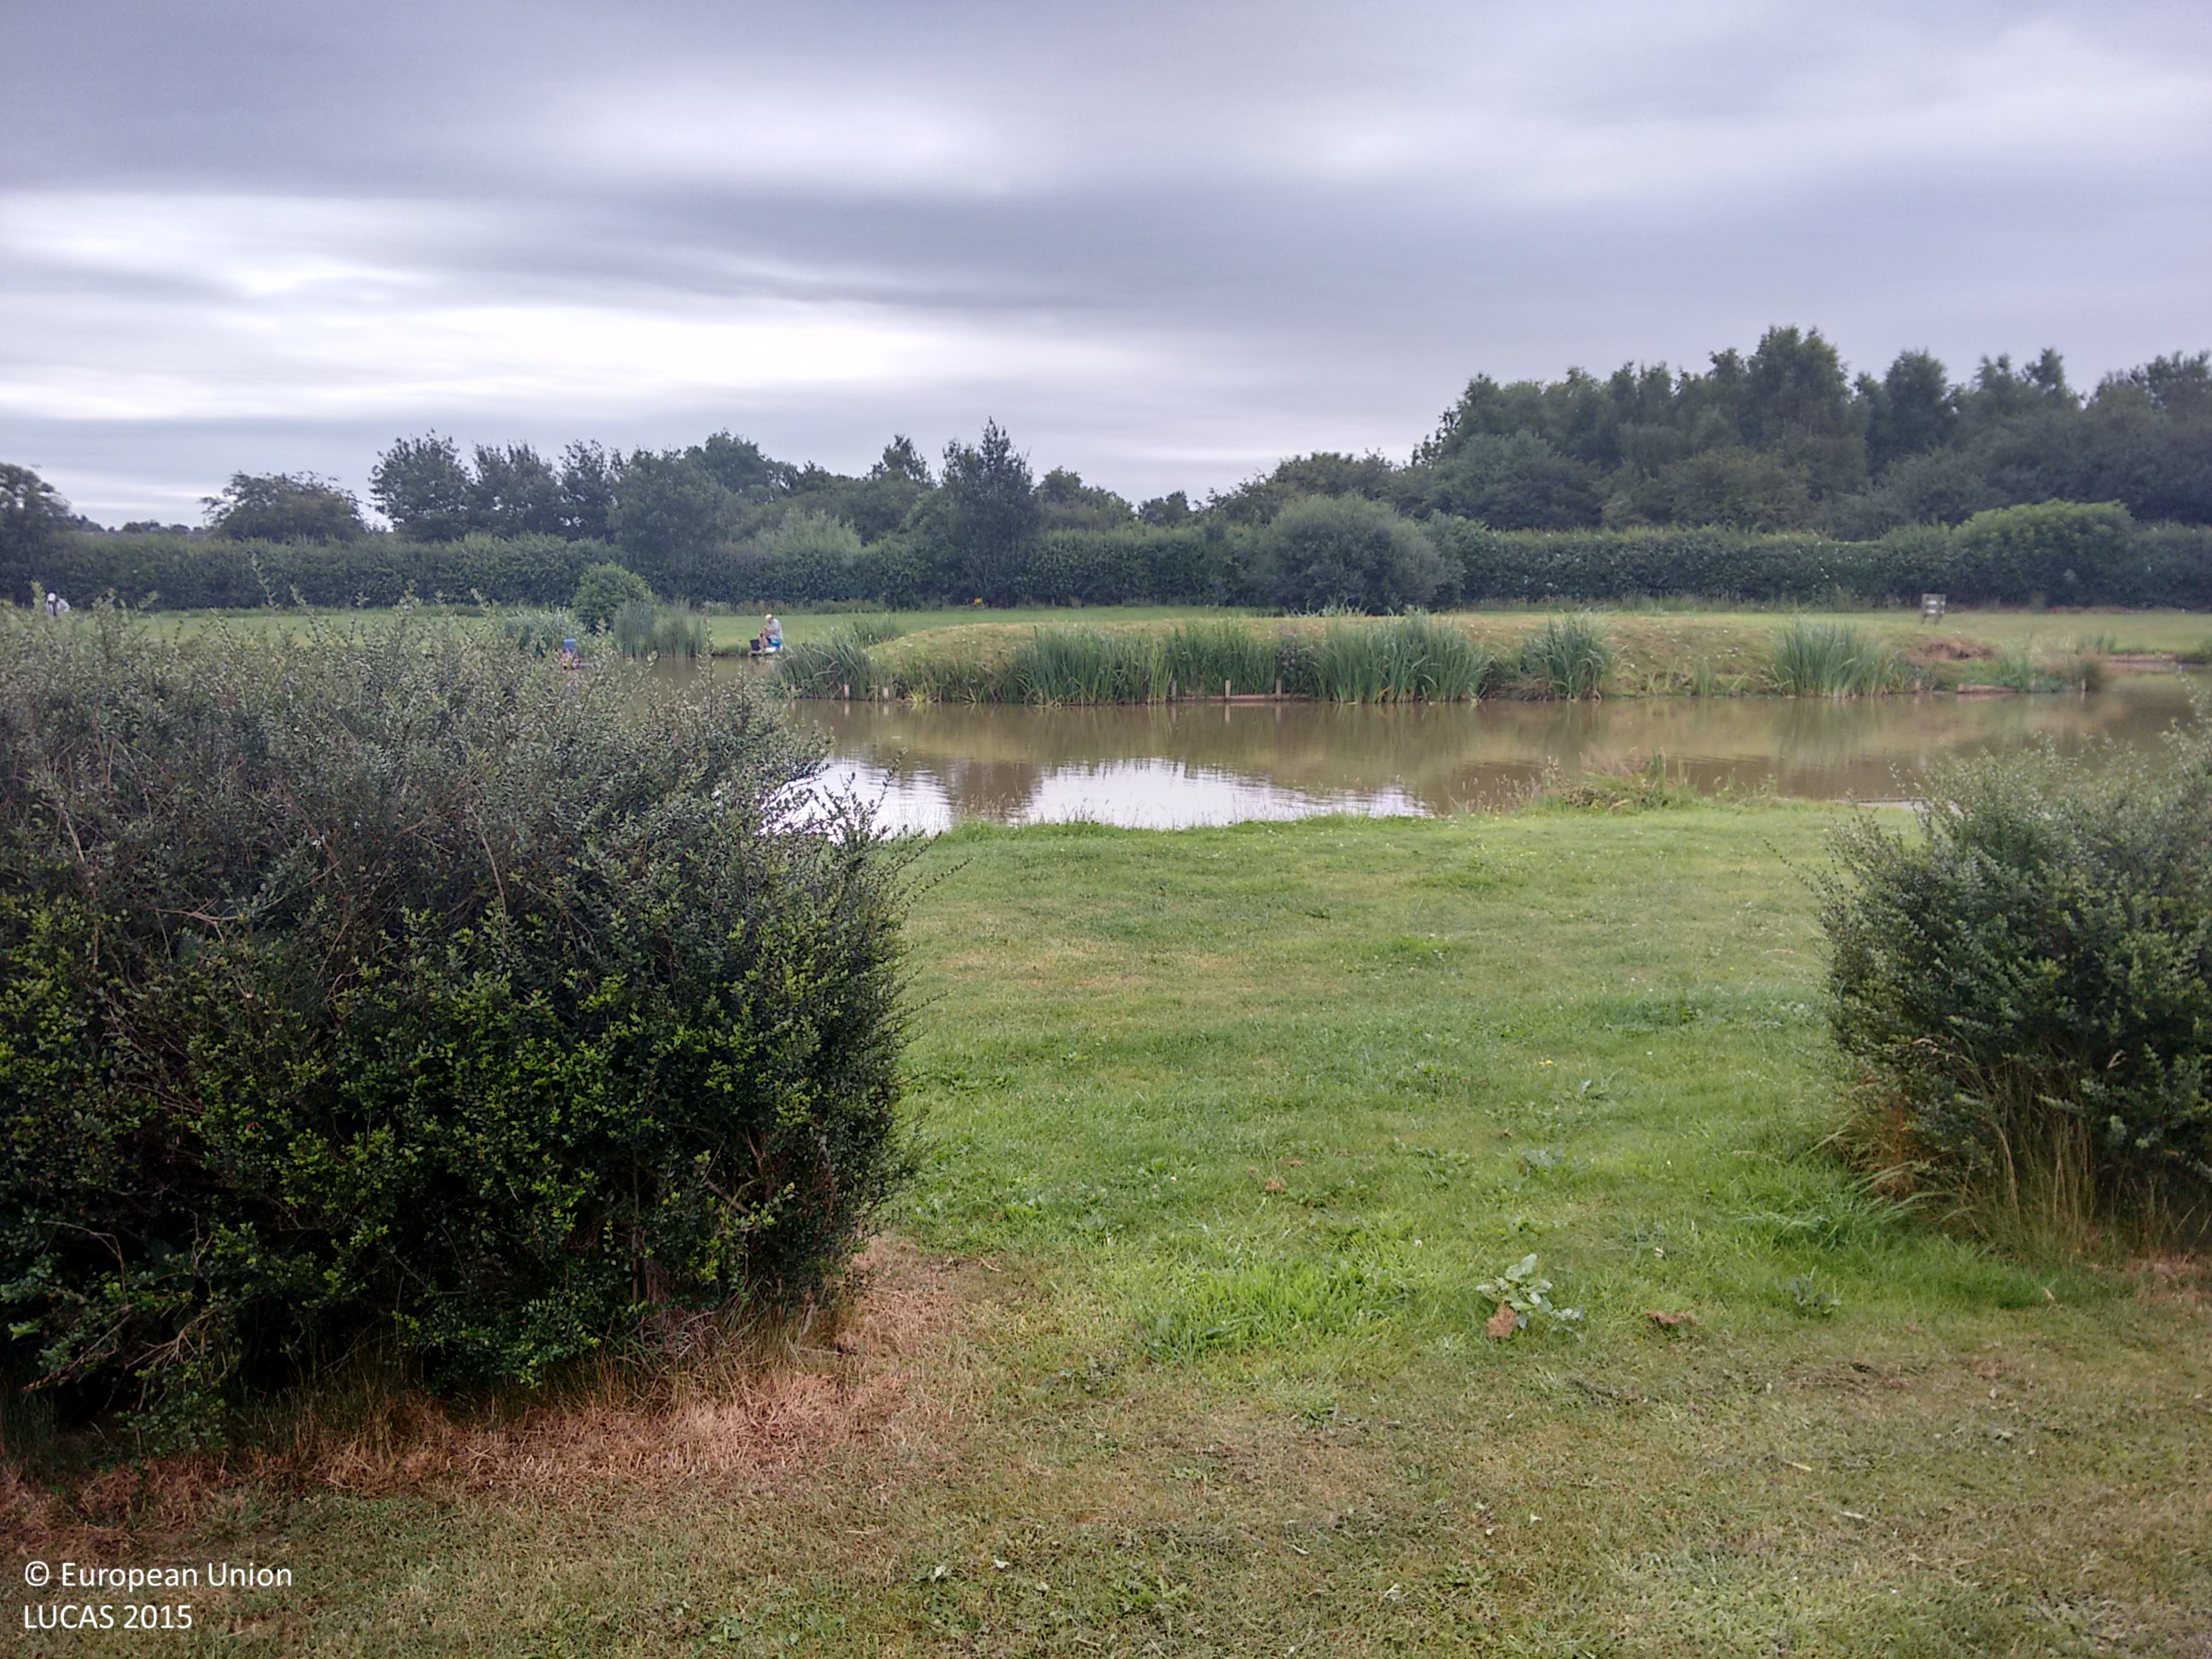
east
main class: Grassland
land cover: Grassland without tree/shrub cover
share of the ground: > 75 %
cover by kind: herbaceous plants 100 %
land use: Amenities, museums, leisure
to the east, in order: Grassland without tree/shrub cover; Inland fresh water bodies; Grassland without tree/shrub cover; Managed hedges; Grass margins; Tracks; Grass margins; Managed hedges; Sugar beet; Abandoned hedges; Grassland without tree/shrub cover; Tracks; Grassland with sparse tree/shrub cover; Artificial constructions in urban areas; Grassland without tree/shrub cover
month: July
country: GB
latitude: 53.2060
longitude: -1.0184
